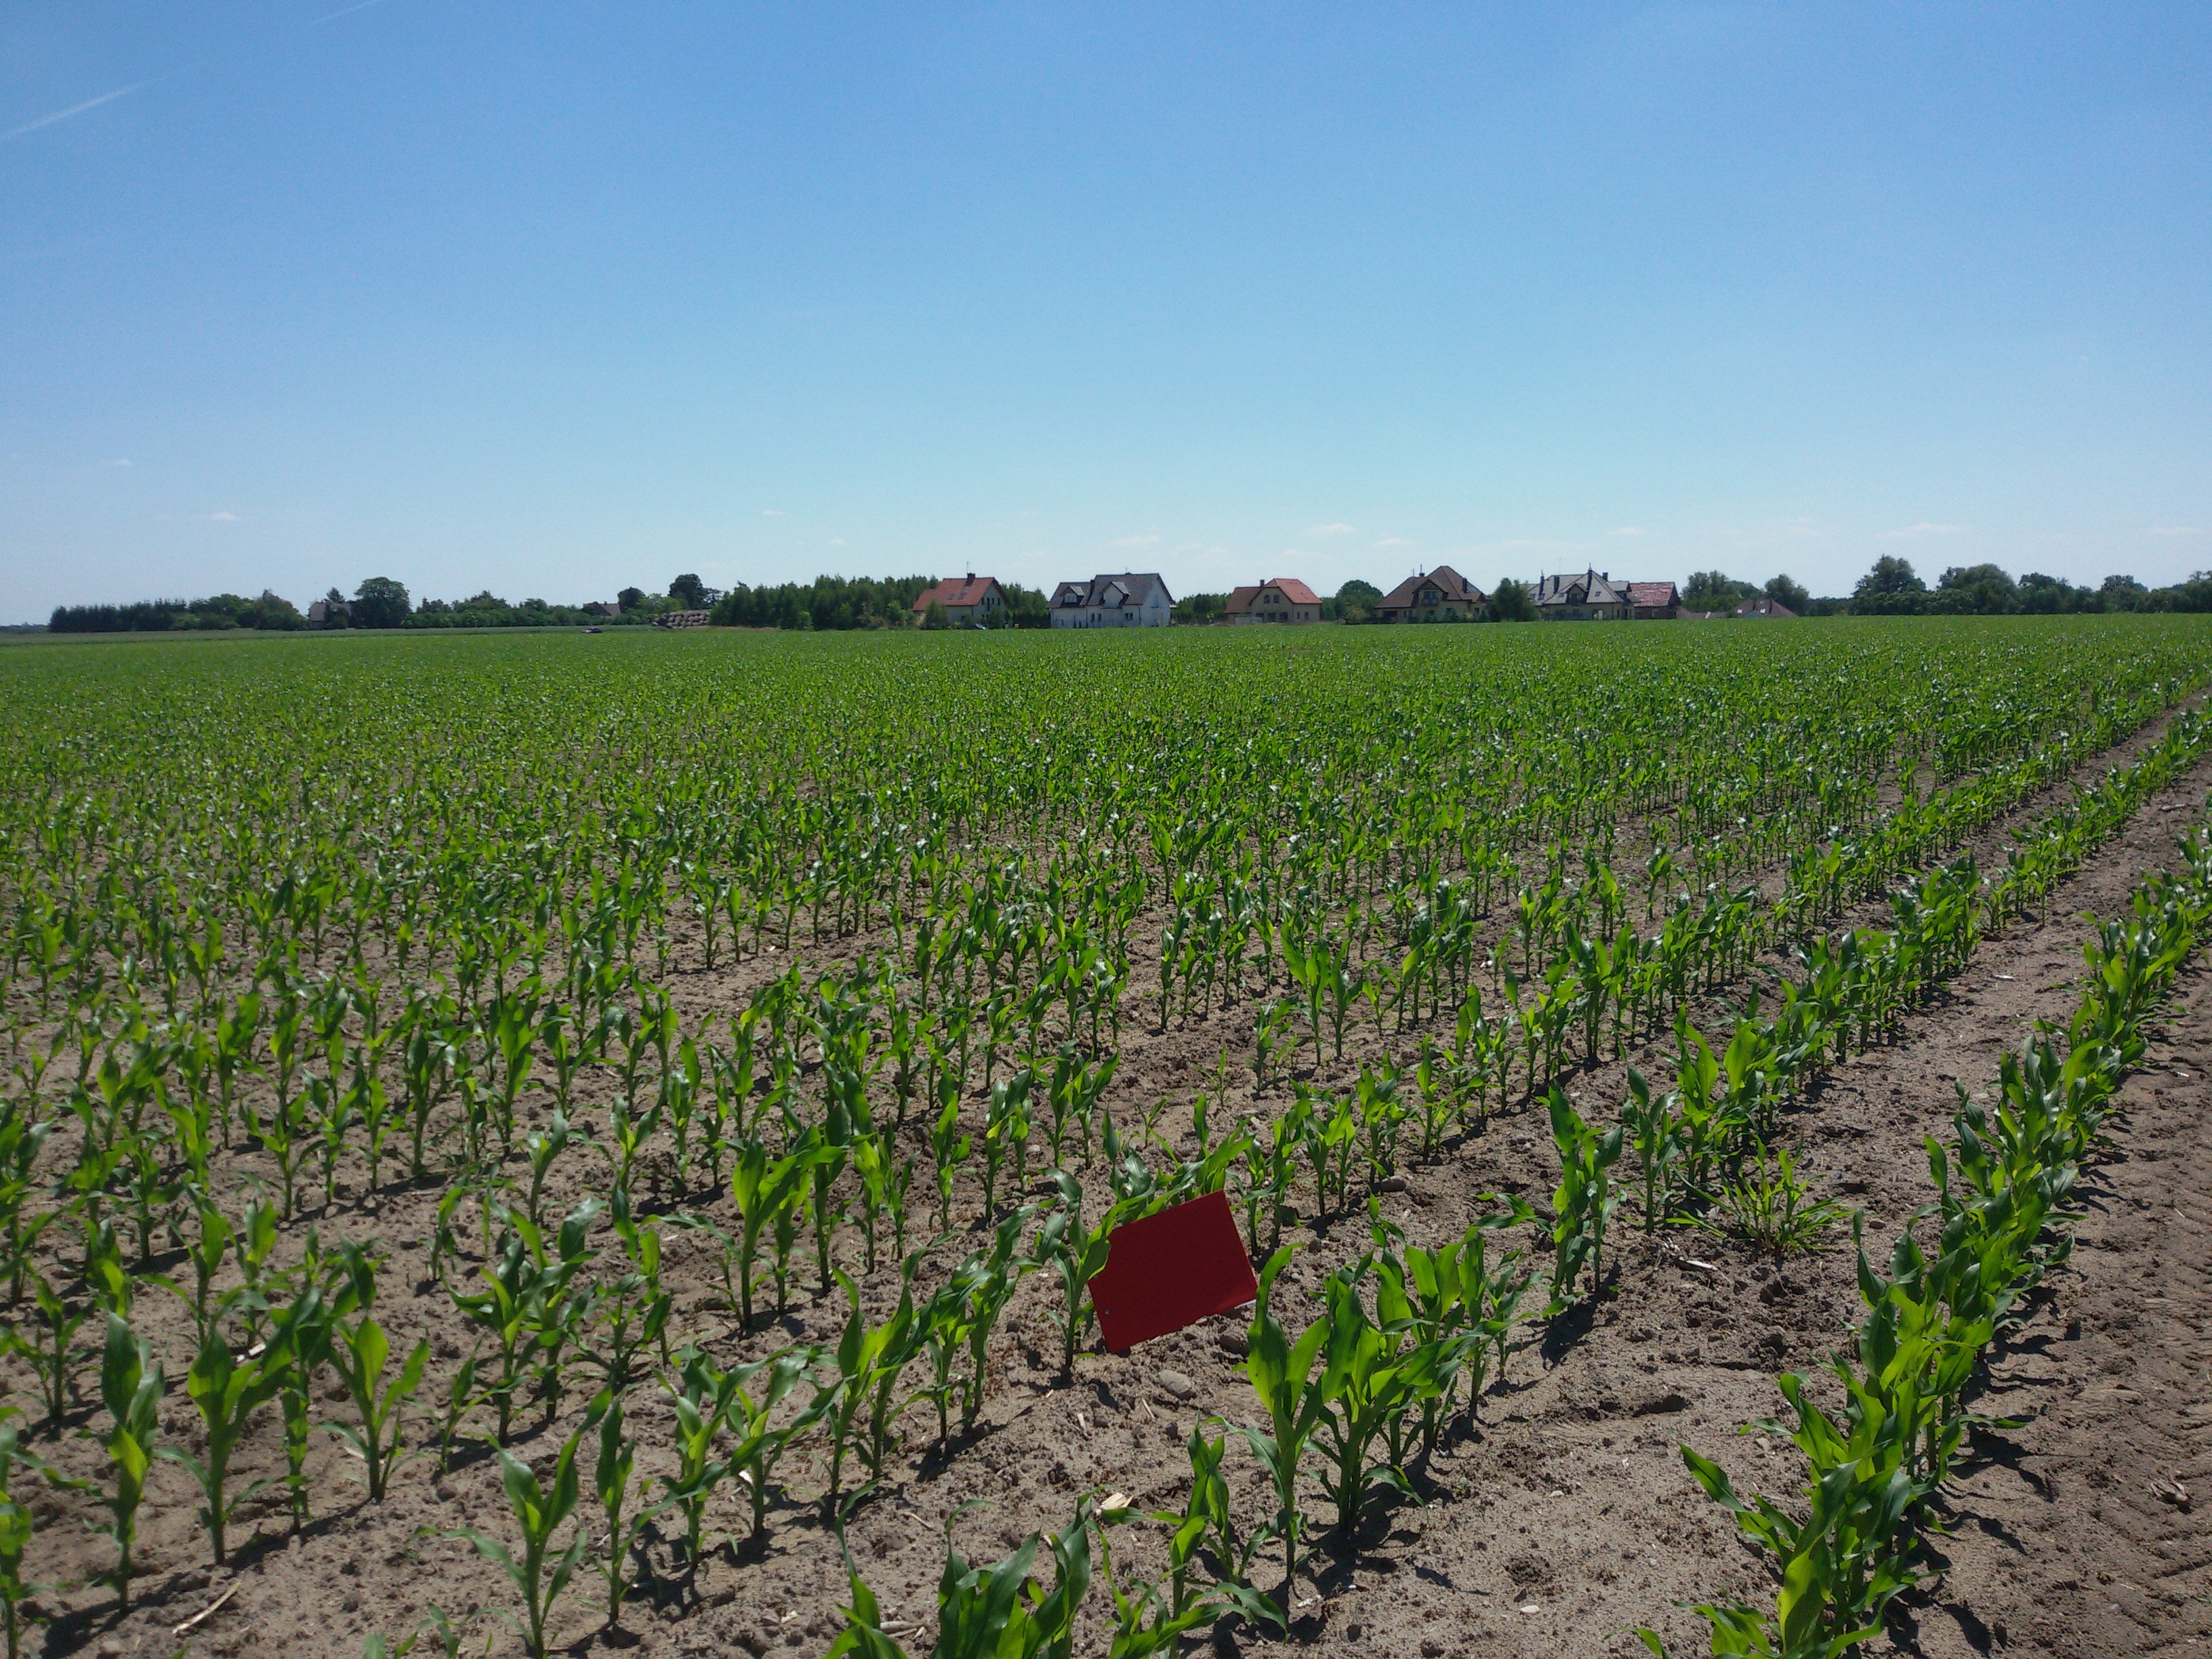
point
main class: Cropland
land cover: Maize
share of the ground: 25 - 50 %
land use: Agriculture (excluding fallow land and kitchen gardens)
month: June
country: PL
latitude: 52.4847
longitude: 17.1821
